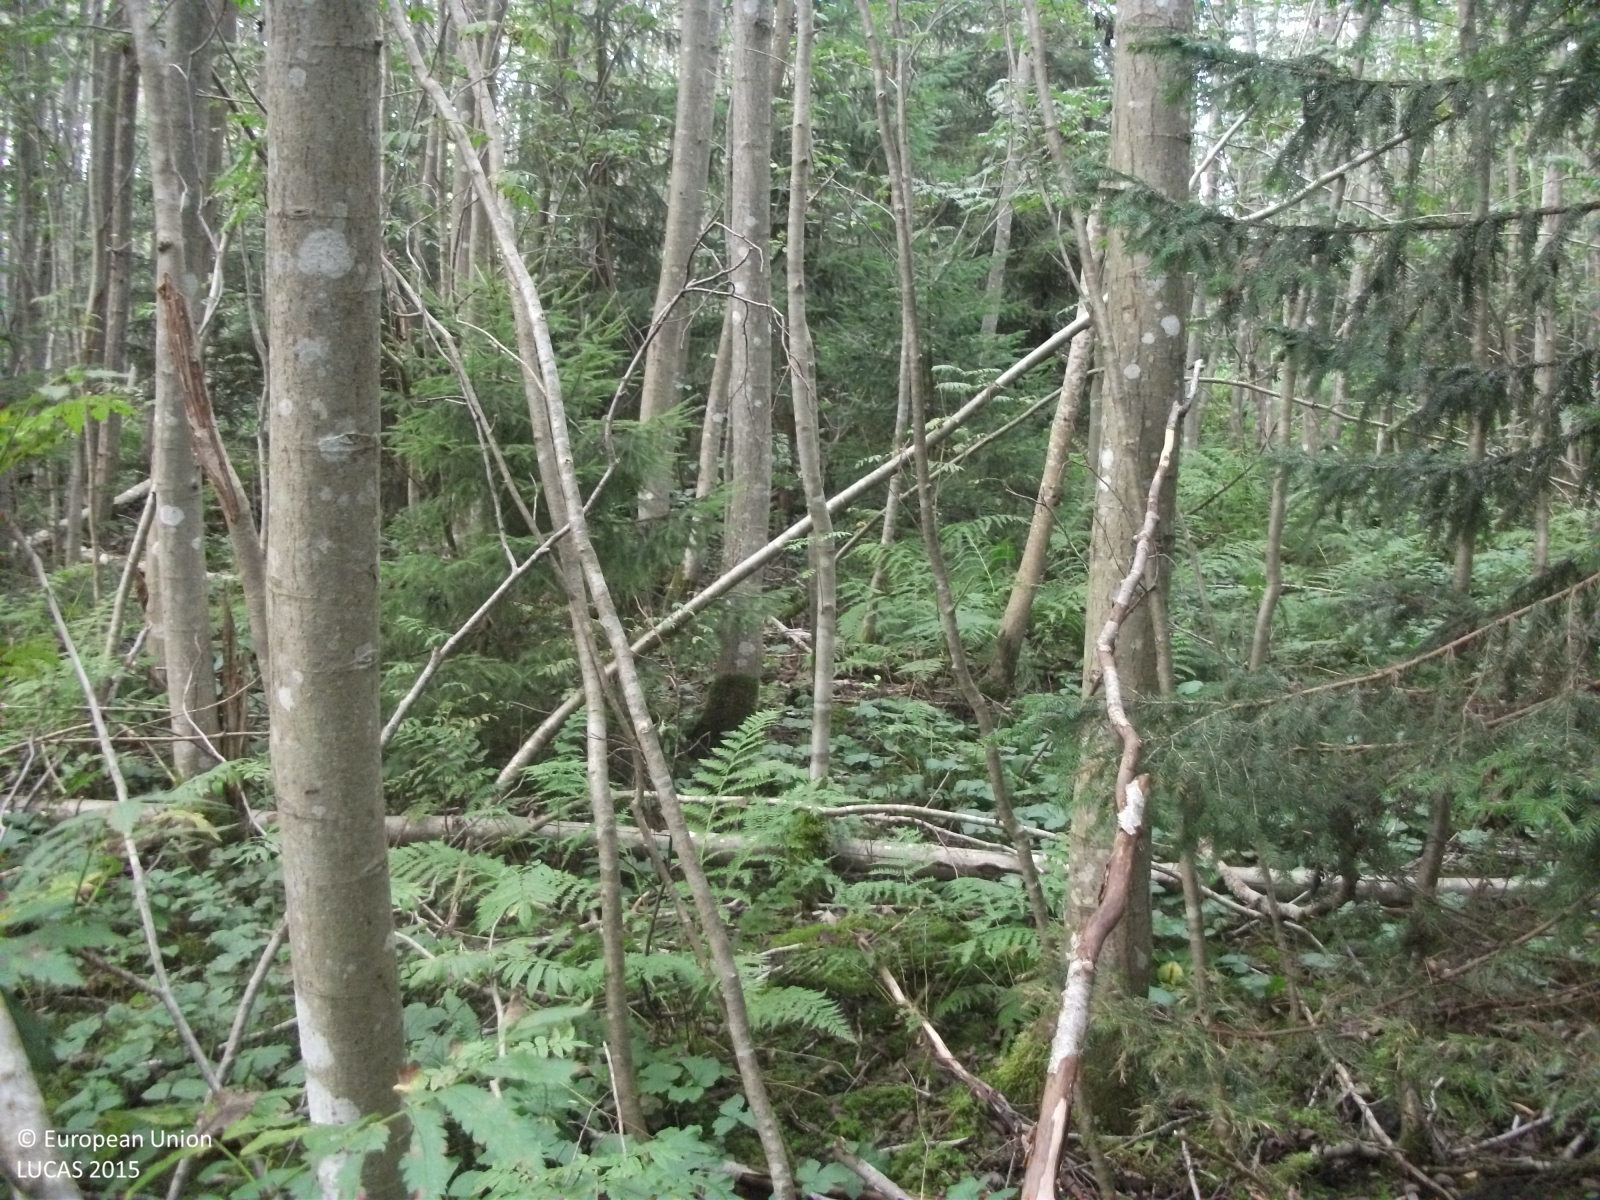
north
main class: Woodland
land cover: Broadleaved woodland
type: non-riverine alder, birch or aspen forest
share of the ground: > 75 %
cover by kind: broadleaved forest trees 85 %, herbaceous plants 10 %, coniferous forest trees 5 %
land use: Forestry
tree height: > 5 m
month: September
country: LV
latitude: 57.5926
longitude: 24.4946
